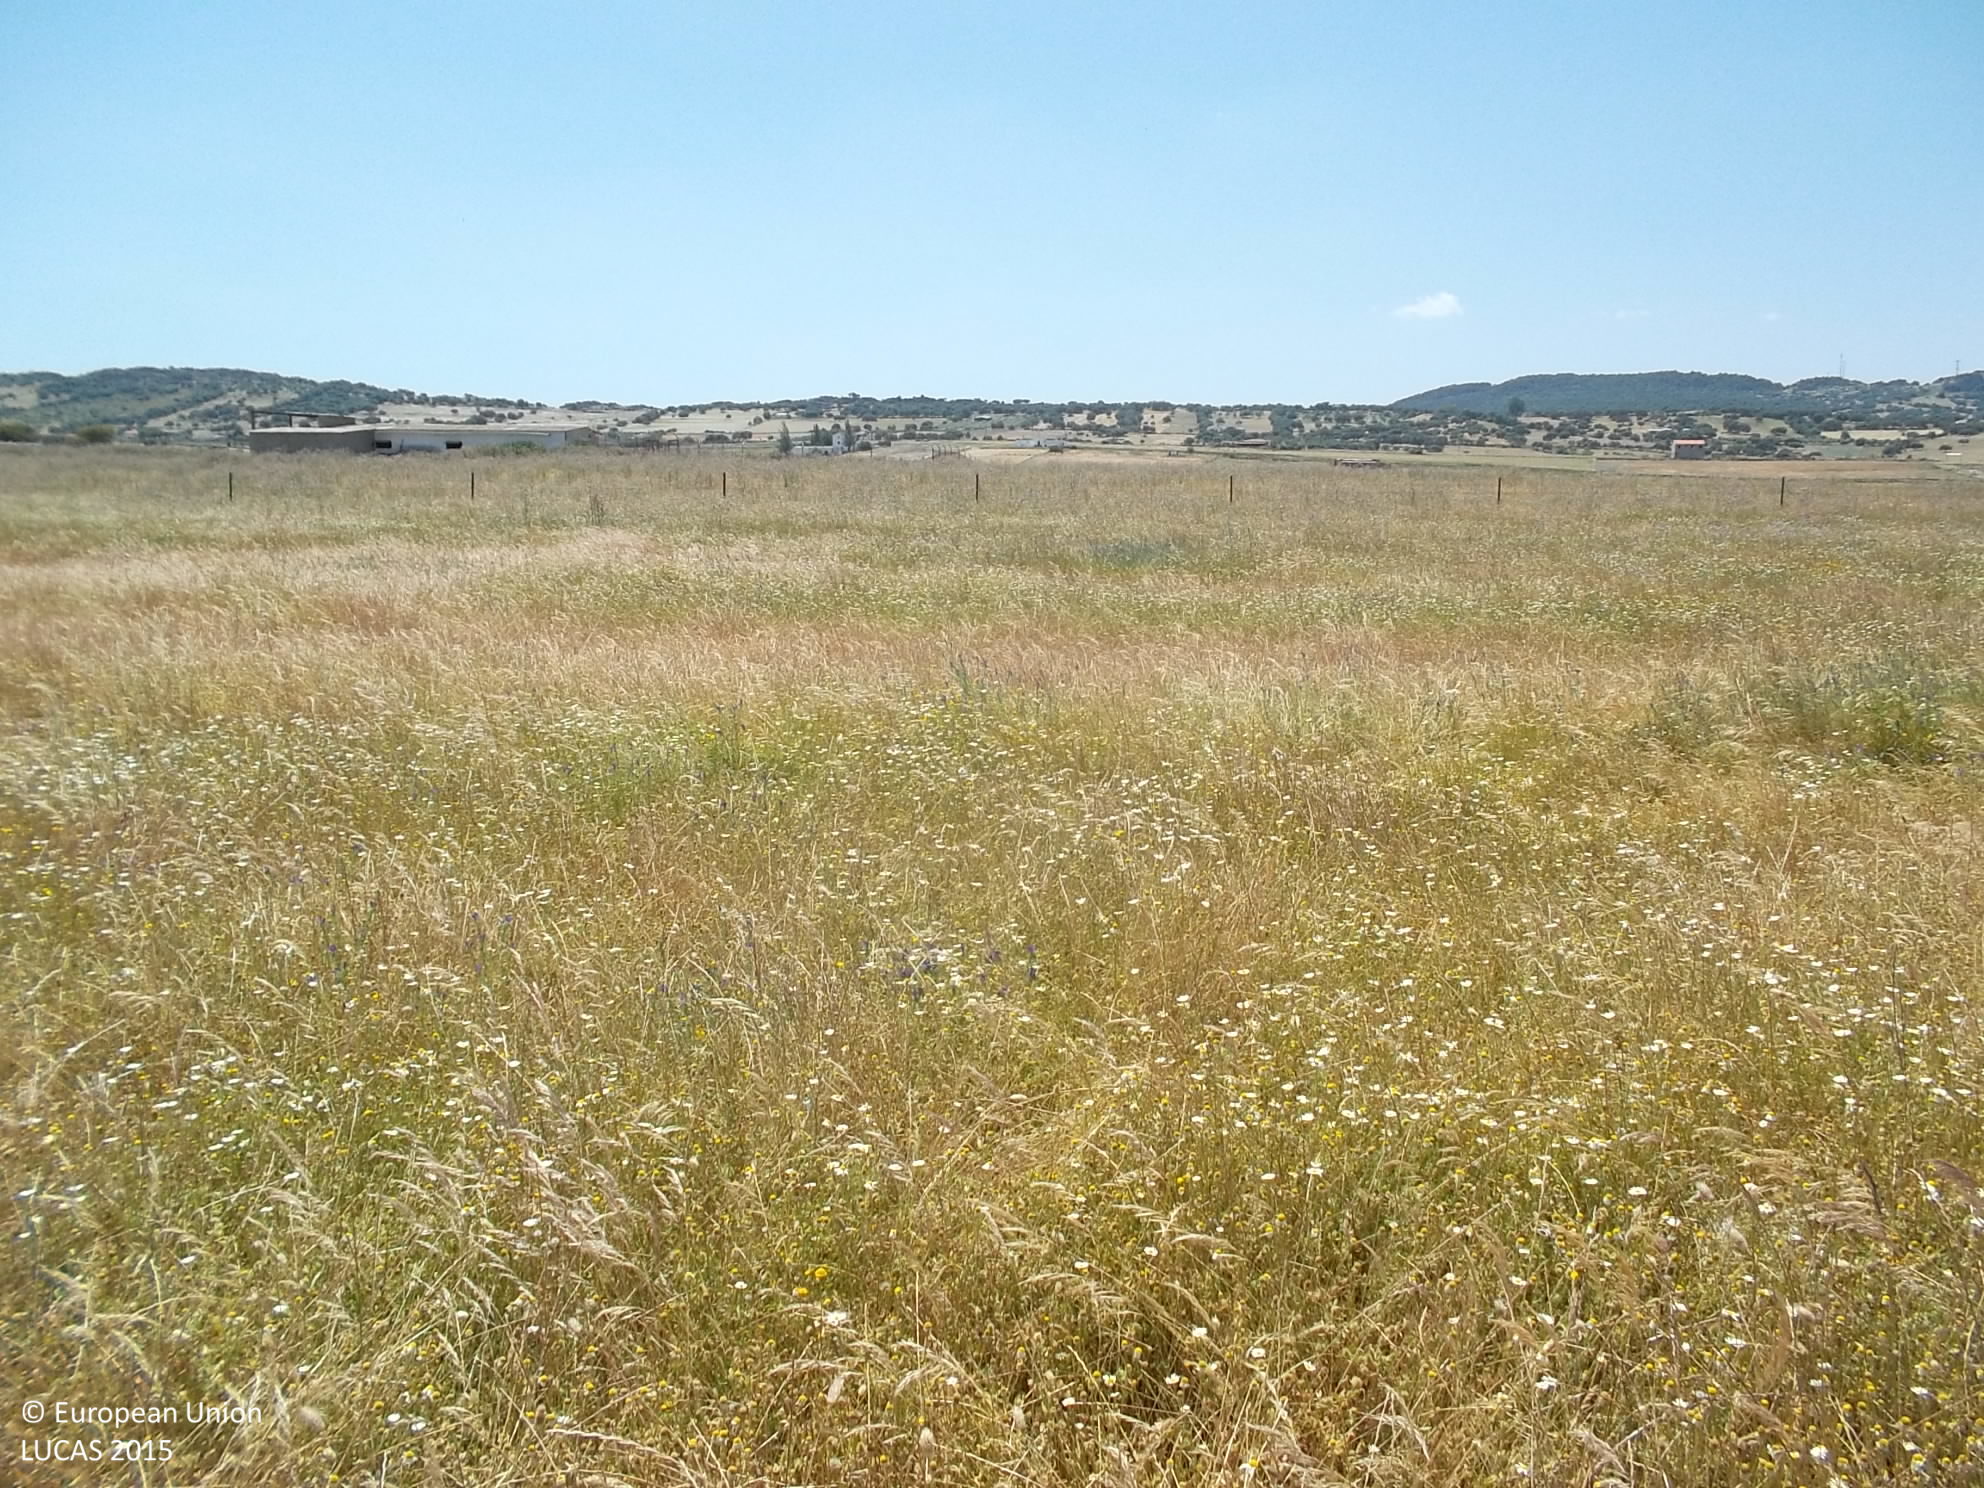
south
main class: Grassland
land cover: Spontaneously vegetated surfaces
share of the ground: > 75 %
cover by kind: herbaceous plants 100 %
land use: Agriculture (excluding fallow land and kitchen gardens)
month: May
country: ES
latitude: 38.7997
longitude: -4.8491
